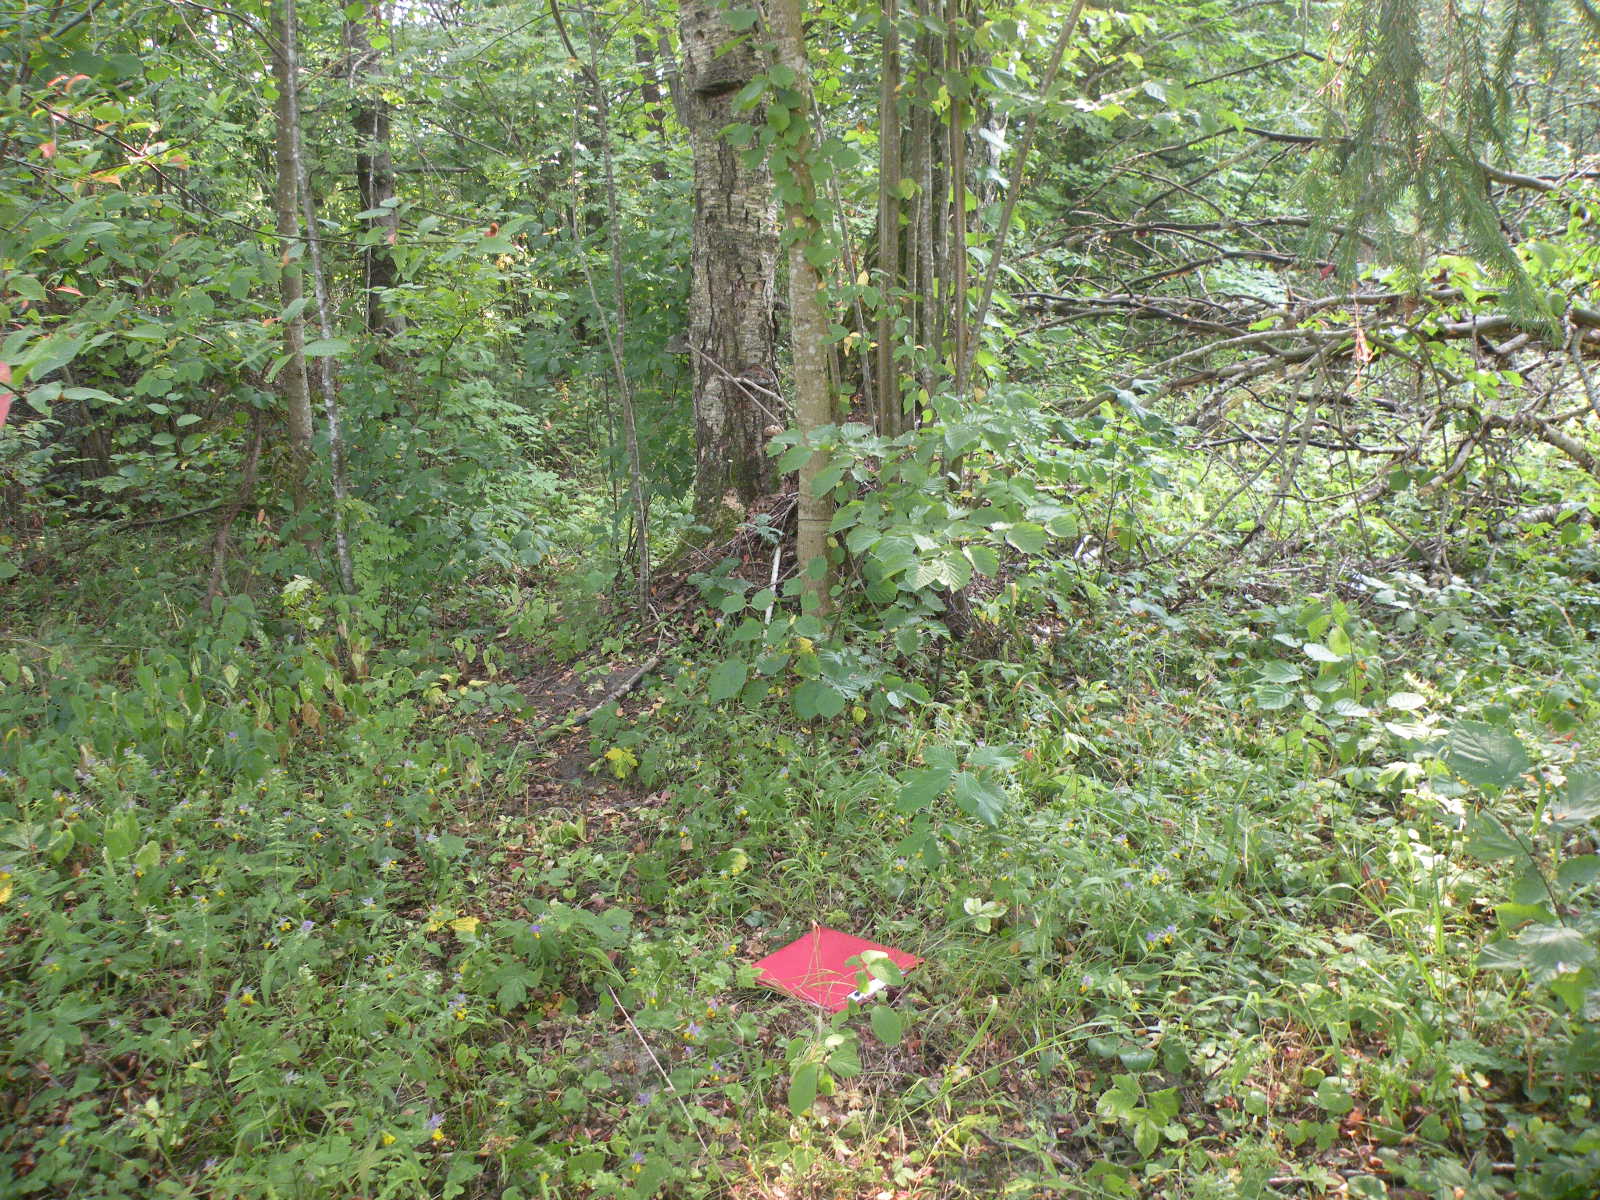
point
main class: Woodland
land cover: Spruce dominated mixed woodland
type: hemiboreal forest and nemoral coniferous forest and mixed broadleaved-coniferous forest
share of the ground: > 75 %
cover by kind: coniferous forest trees 60 %, broadleaved forest trees 25 %, herbaceous plants 10 %, shrubs 5 %
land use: Forestry
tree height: > 5 m
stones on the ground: < 10 %
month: August
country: LV
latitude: 55.7730
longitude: 26.6221
